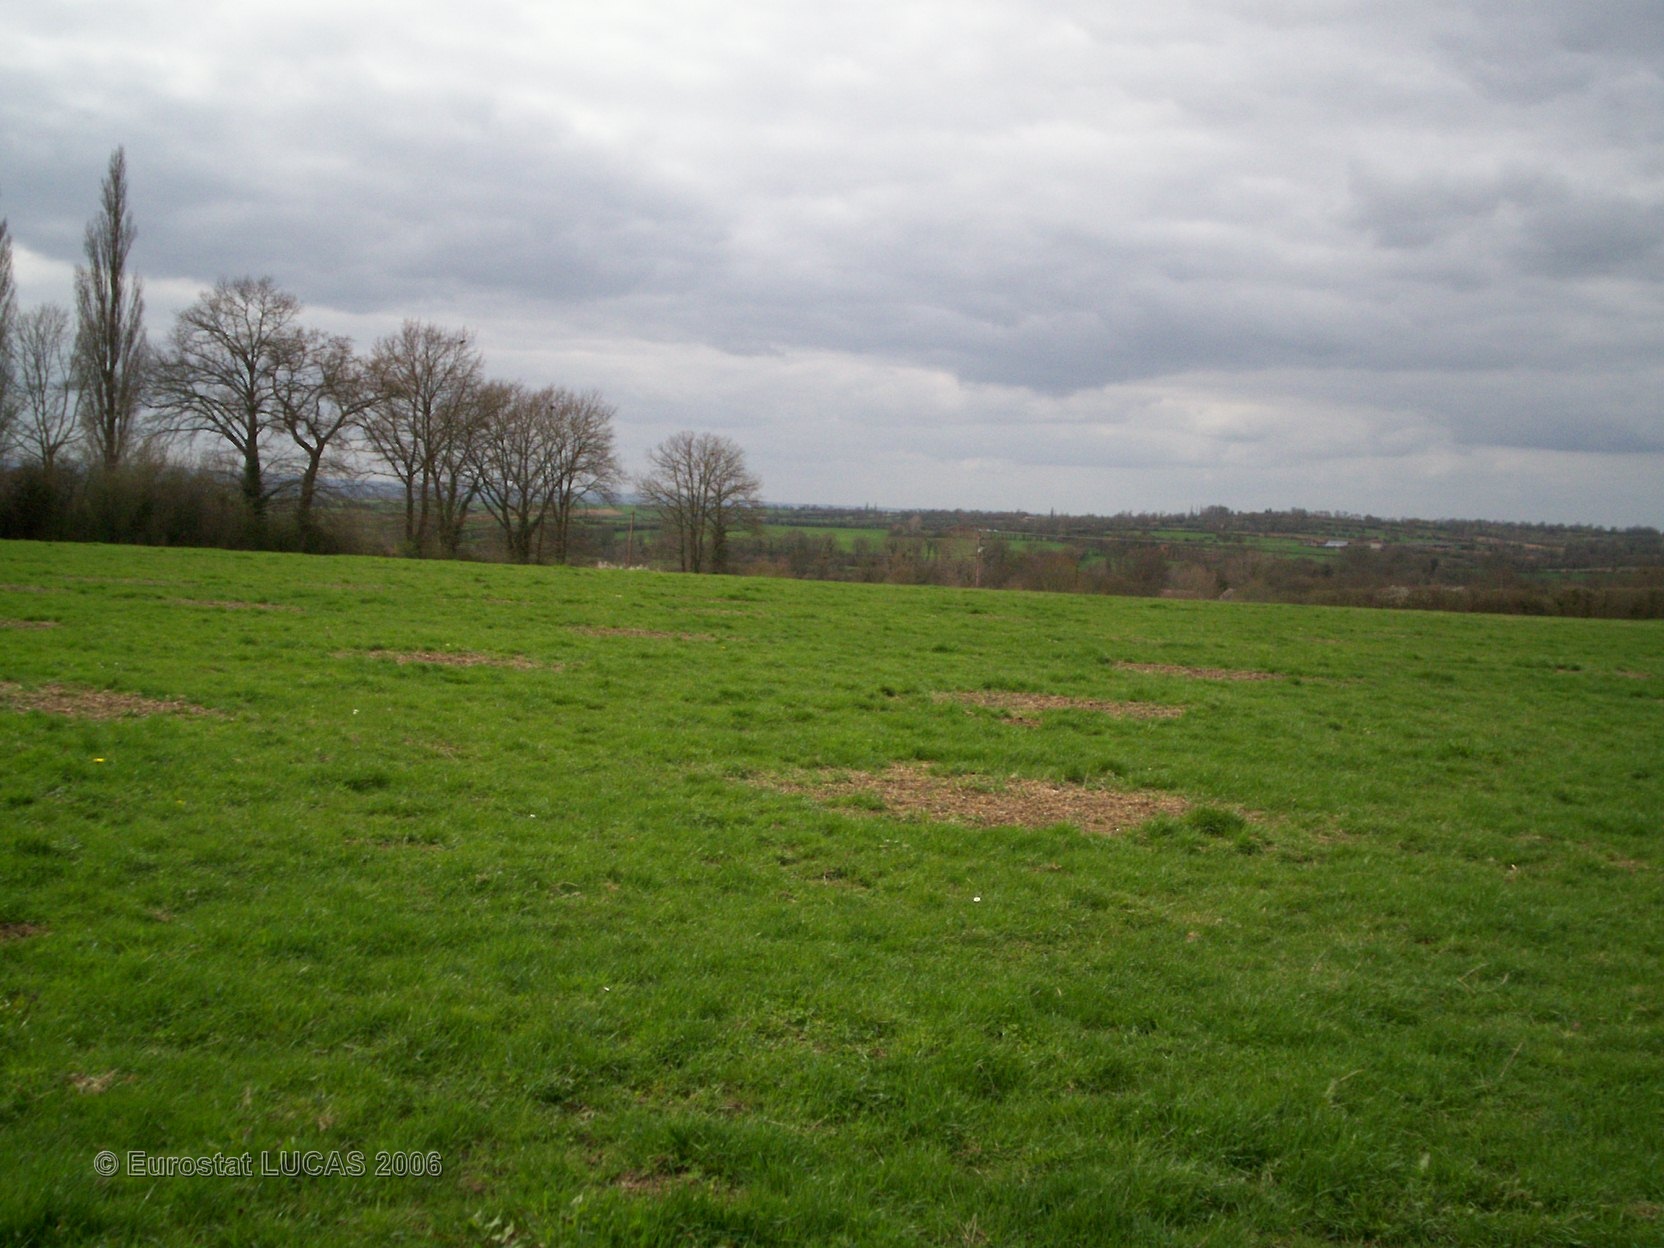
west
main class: Grassland
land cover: Grassland without tree/shrub cover
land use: Agriculture (excluding fallow land and kitchen gardens)
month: April
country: FR
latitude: 48.8455
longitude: 0.0912
